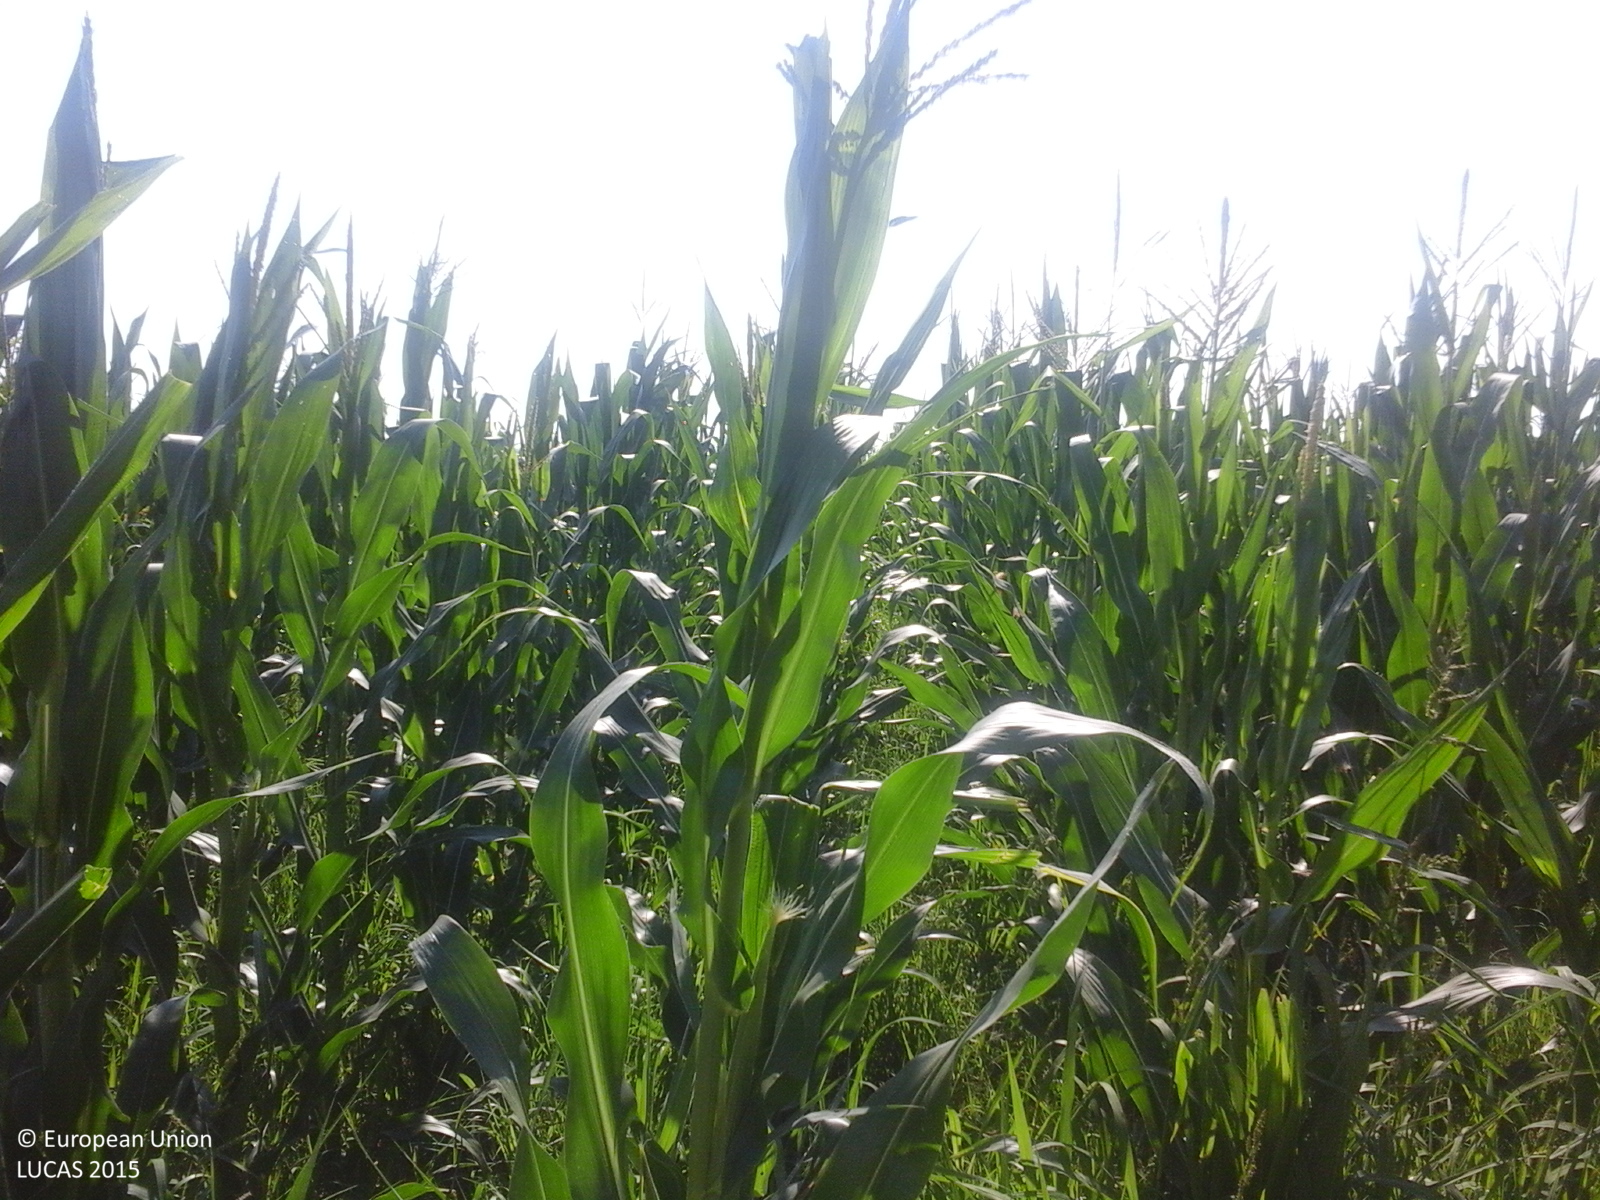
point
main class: Cropland
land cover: Maize
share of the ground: > 75 %
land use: Agriculture (excluding fallow land and kitchen gardens)
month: July
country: RO
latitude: 44.6556
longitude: 24.2804
